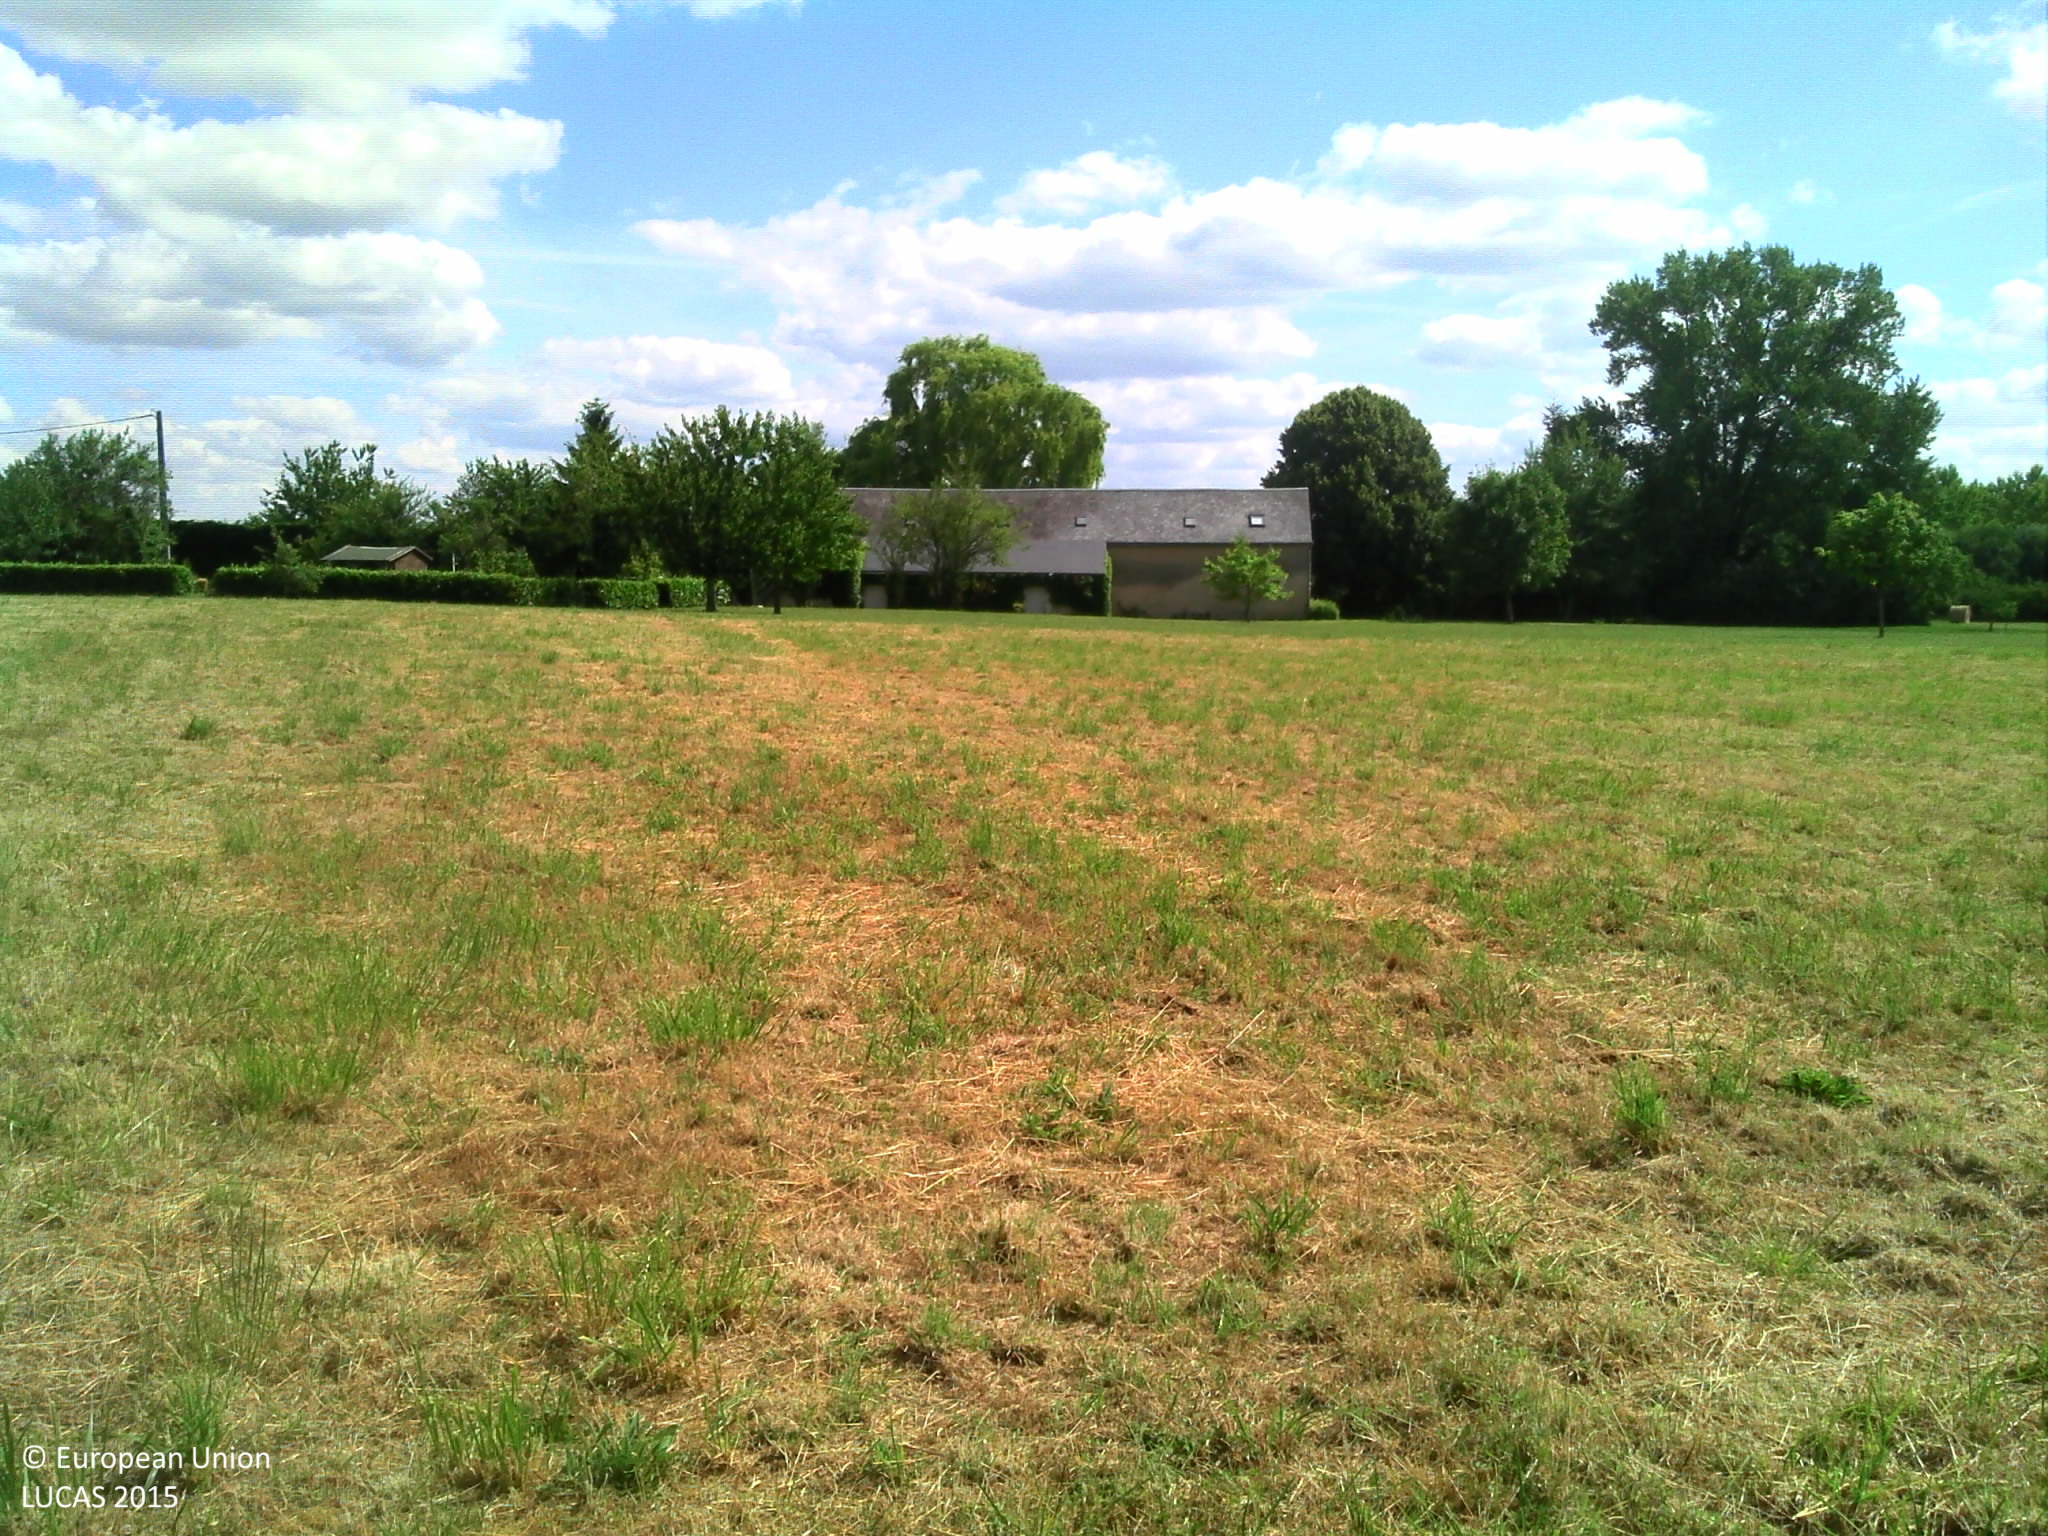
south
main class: Grassland
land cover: Grassland without tree/shrub cover
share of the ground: > 75 %
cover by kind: herbaceous plants 100 %
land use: Agriculture (excluding fallow land and kitchen gardens)
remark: Harvested field
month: June
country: FR
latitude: 47.4869
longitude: 0.3016
